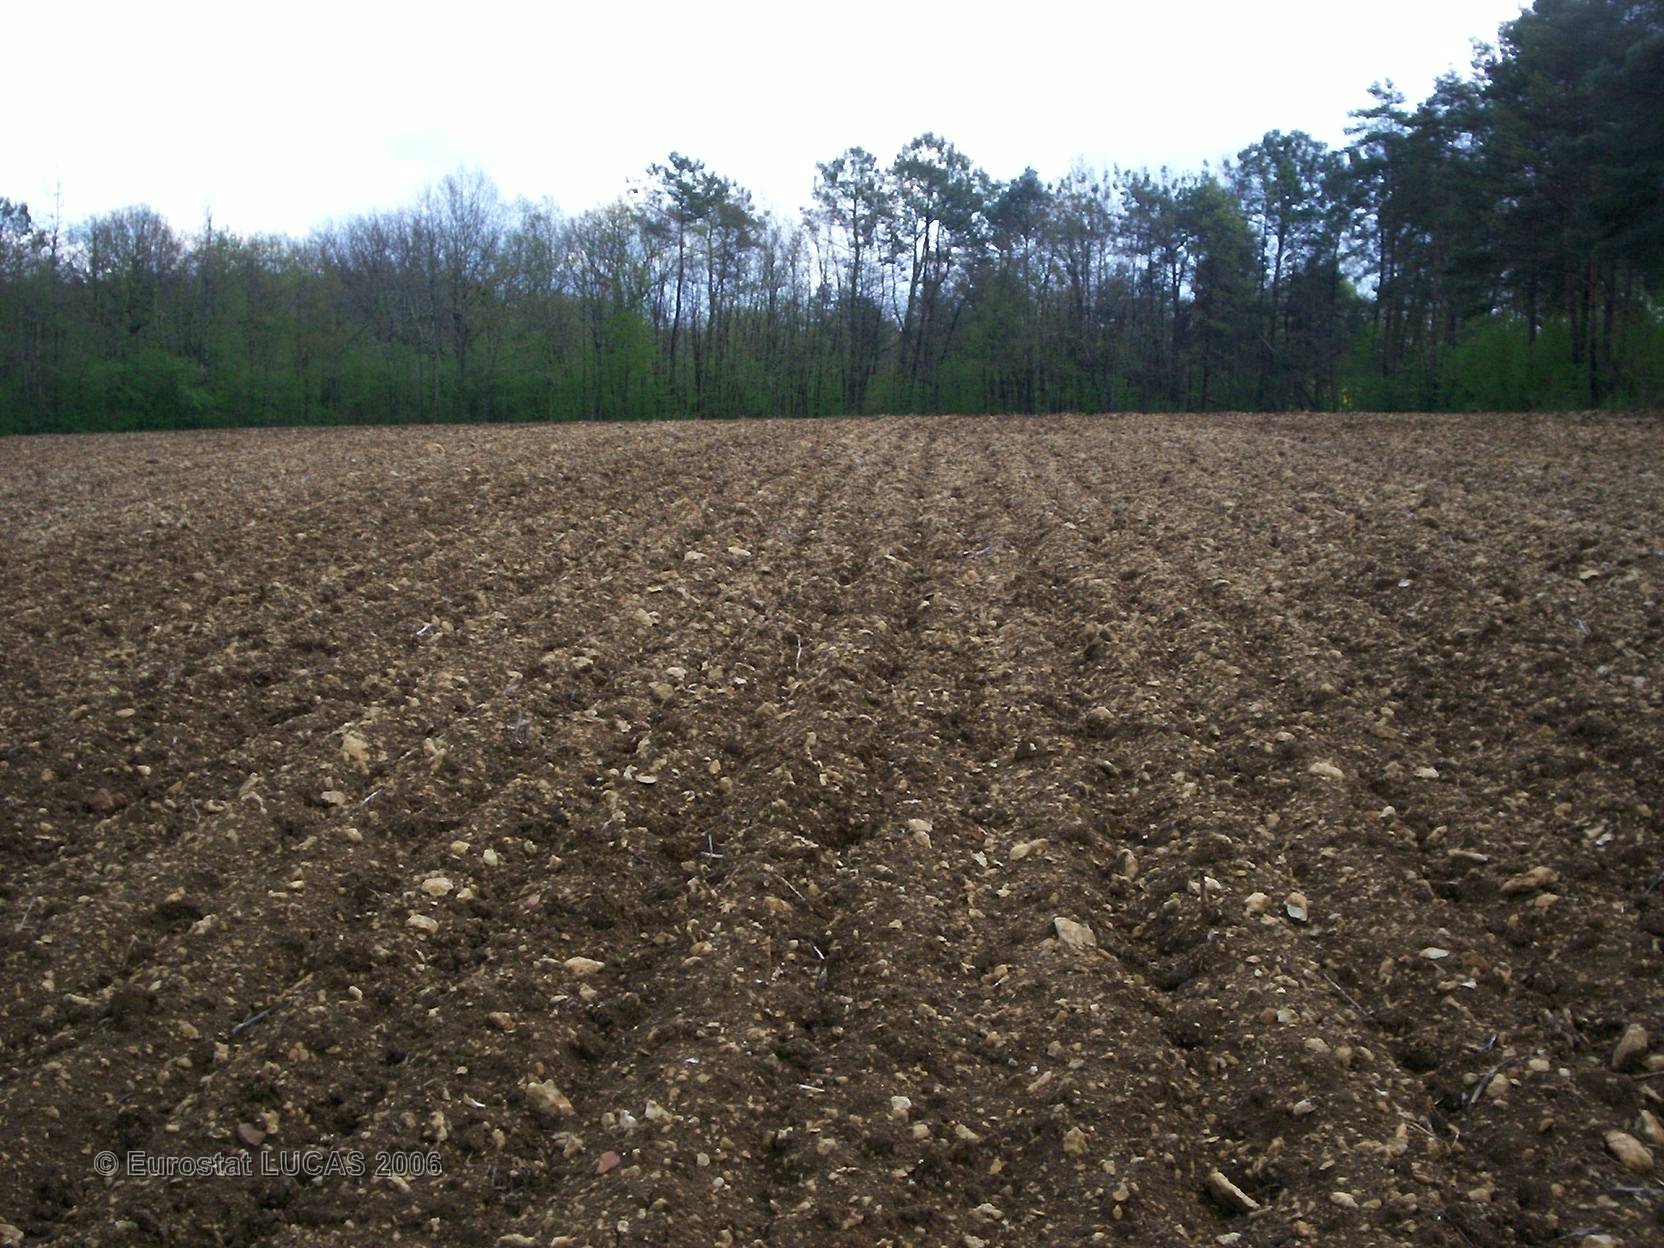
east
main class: Cropland
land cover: Maize
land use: Agriculture (excluding fallow land and kitchen gardens)
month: June
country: FR
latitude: 45.3881
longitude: 0.7550
